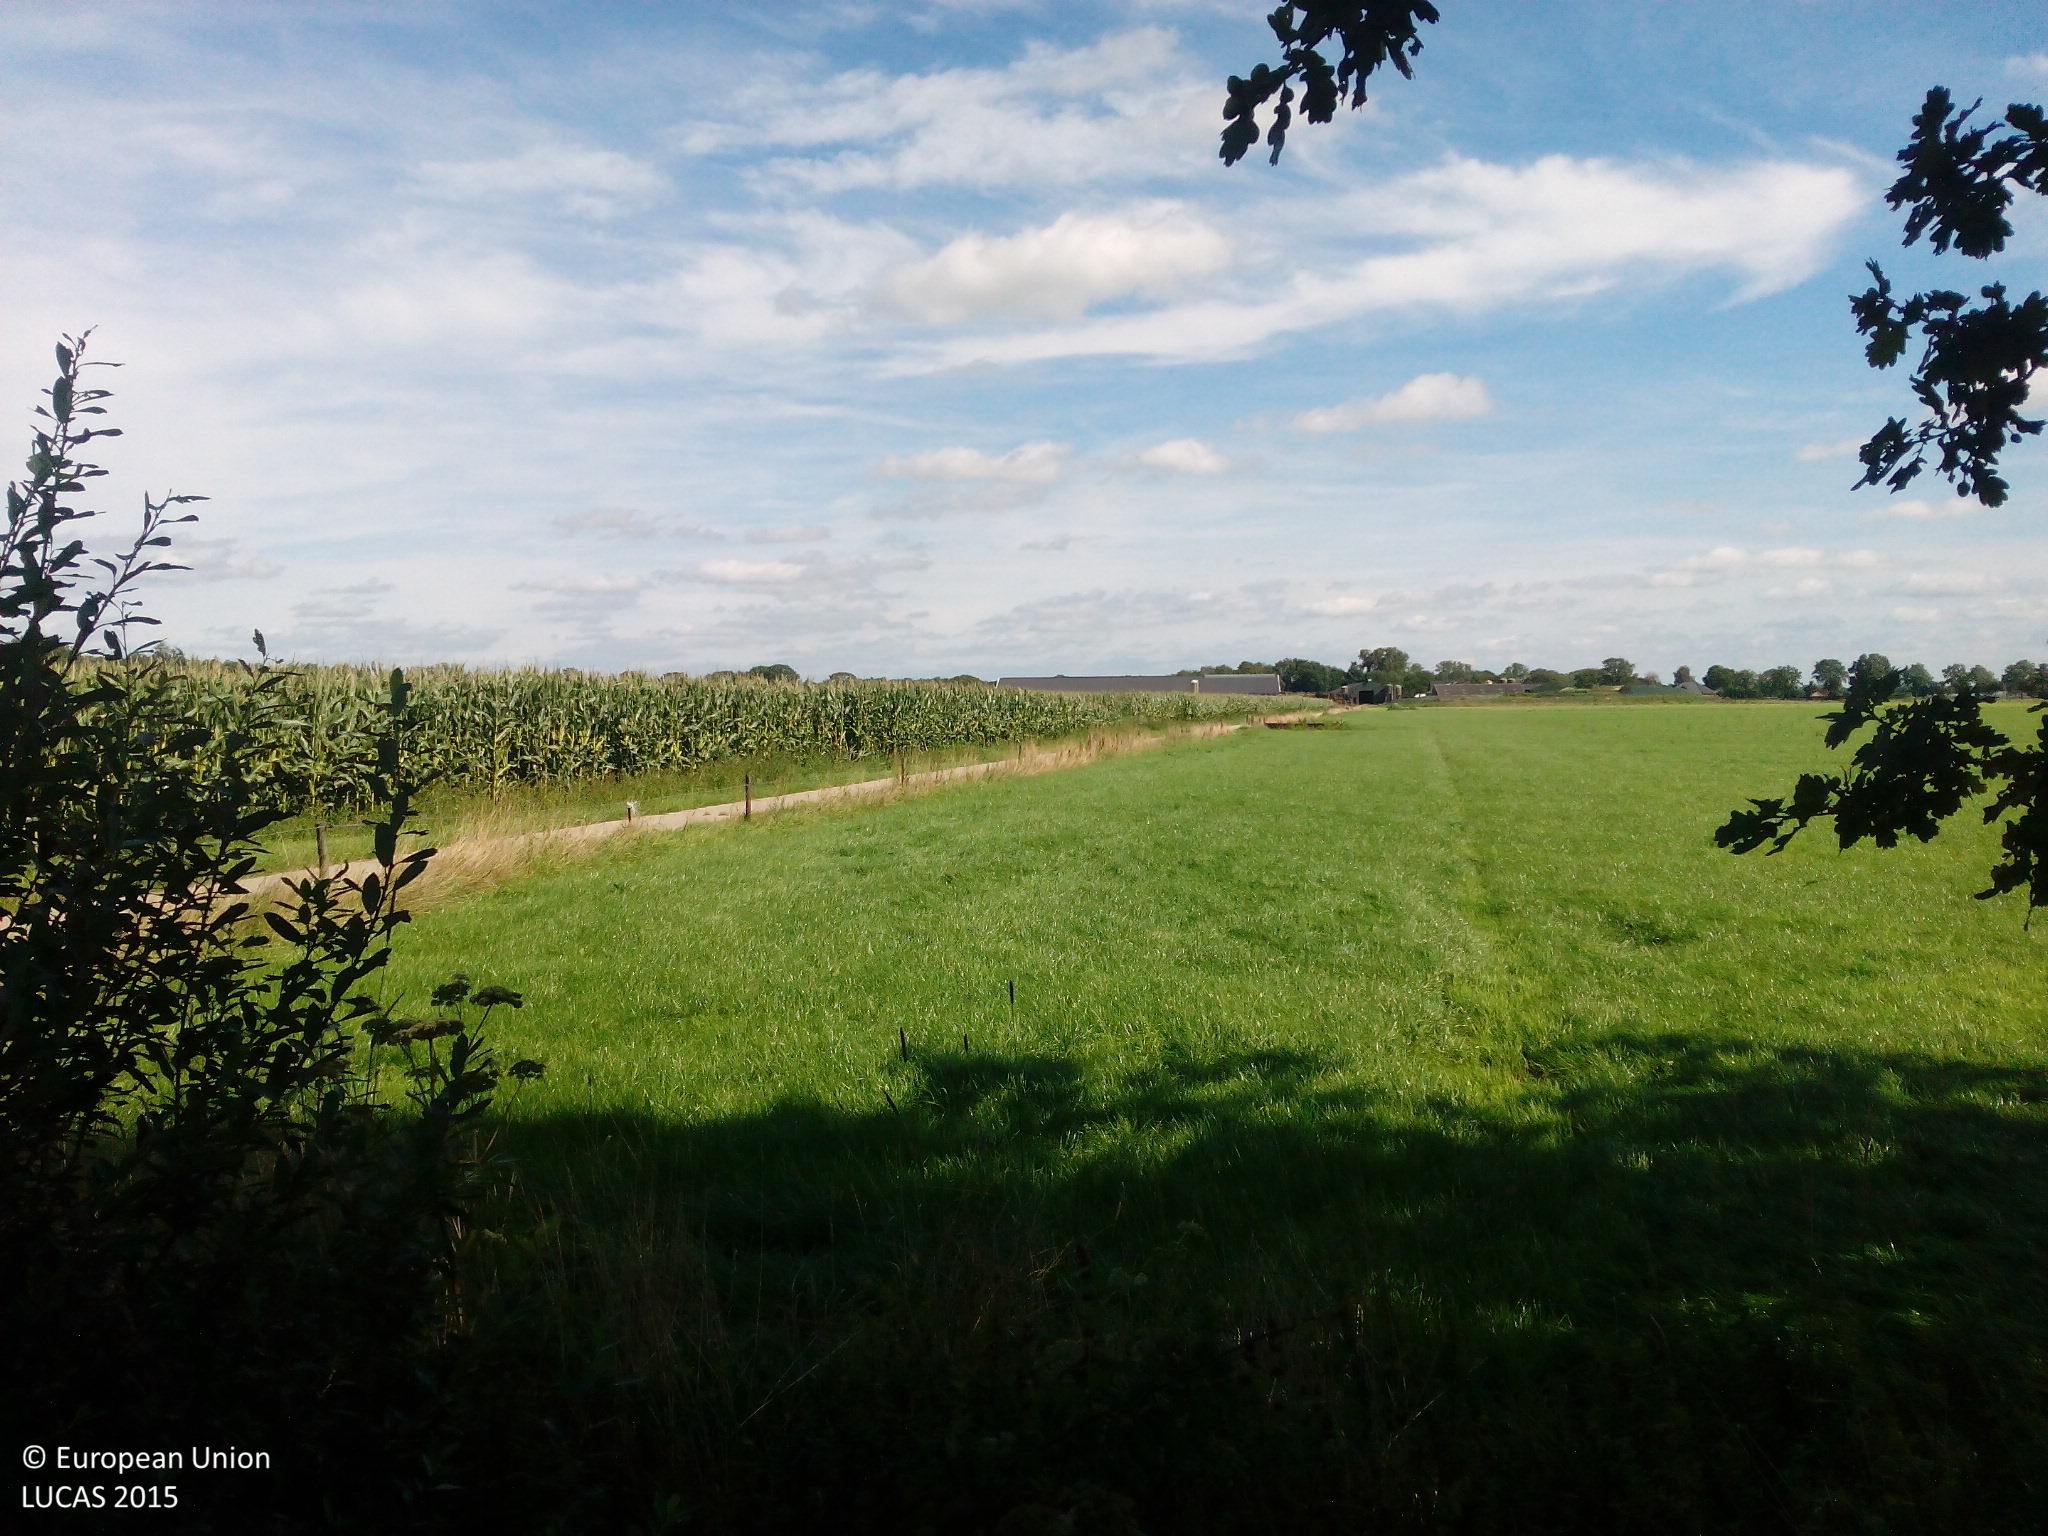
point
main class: Cropland
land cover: Maize
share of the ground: > 75 %
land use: Agriculture (excluding fallow land and kitchen gardens)
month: August
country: NL
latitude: 51.3099
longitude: 5.7091
